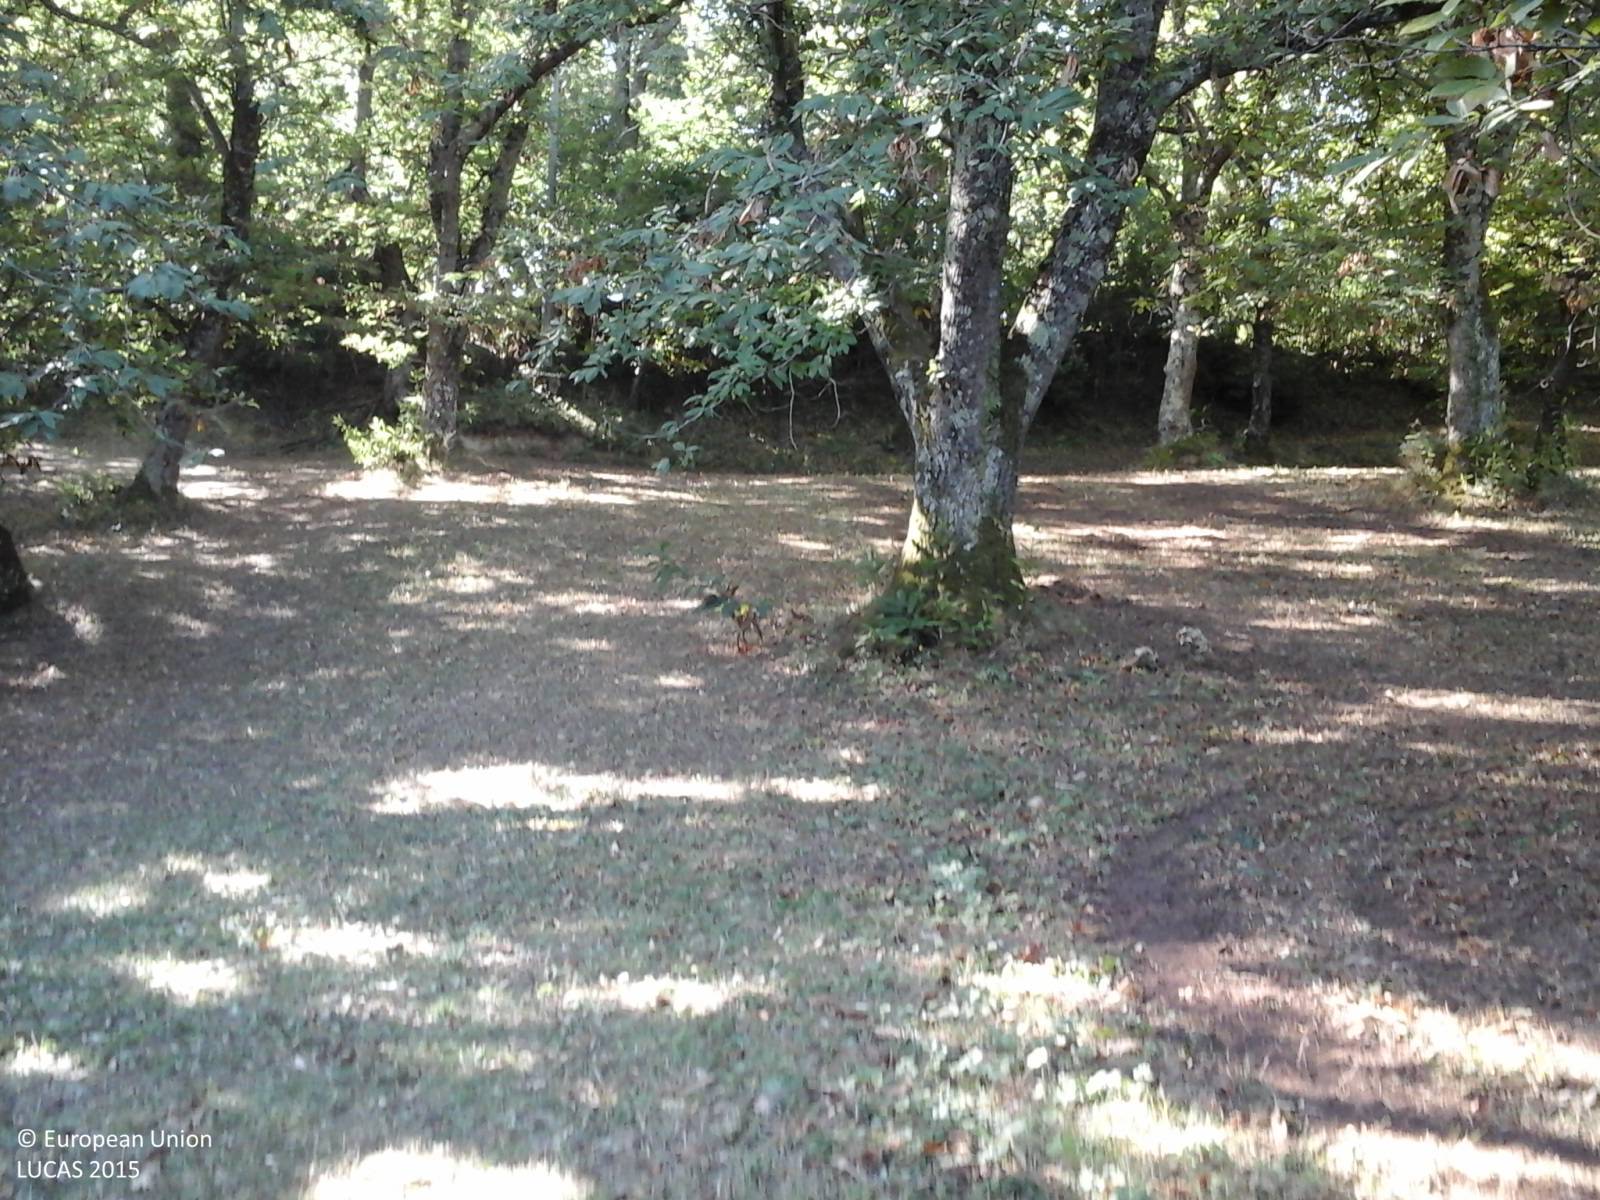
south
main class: Cropland
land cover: Nuts trees
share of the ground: > 75 %
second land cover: Grassland without tree/shrub cover
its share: 10 - 25 %
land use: Agriculture (excluding fallow land and kitchen gardens)
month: September
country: IT
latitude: 42.3763
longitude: 12.2391
